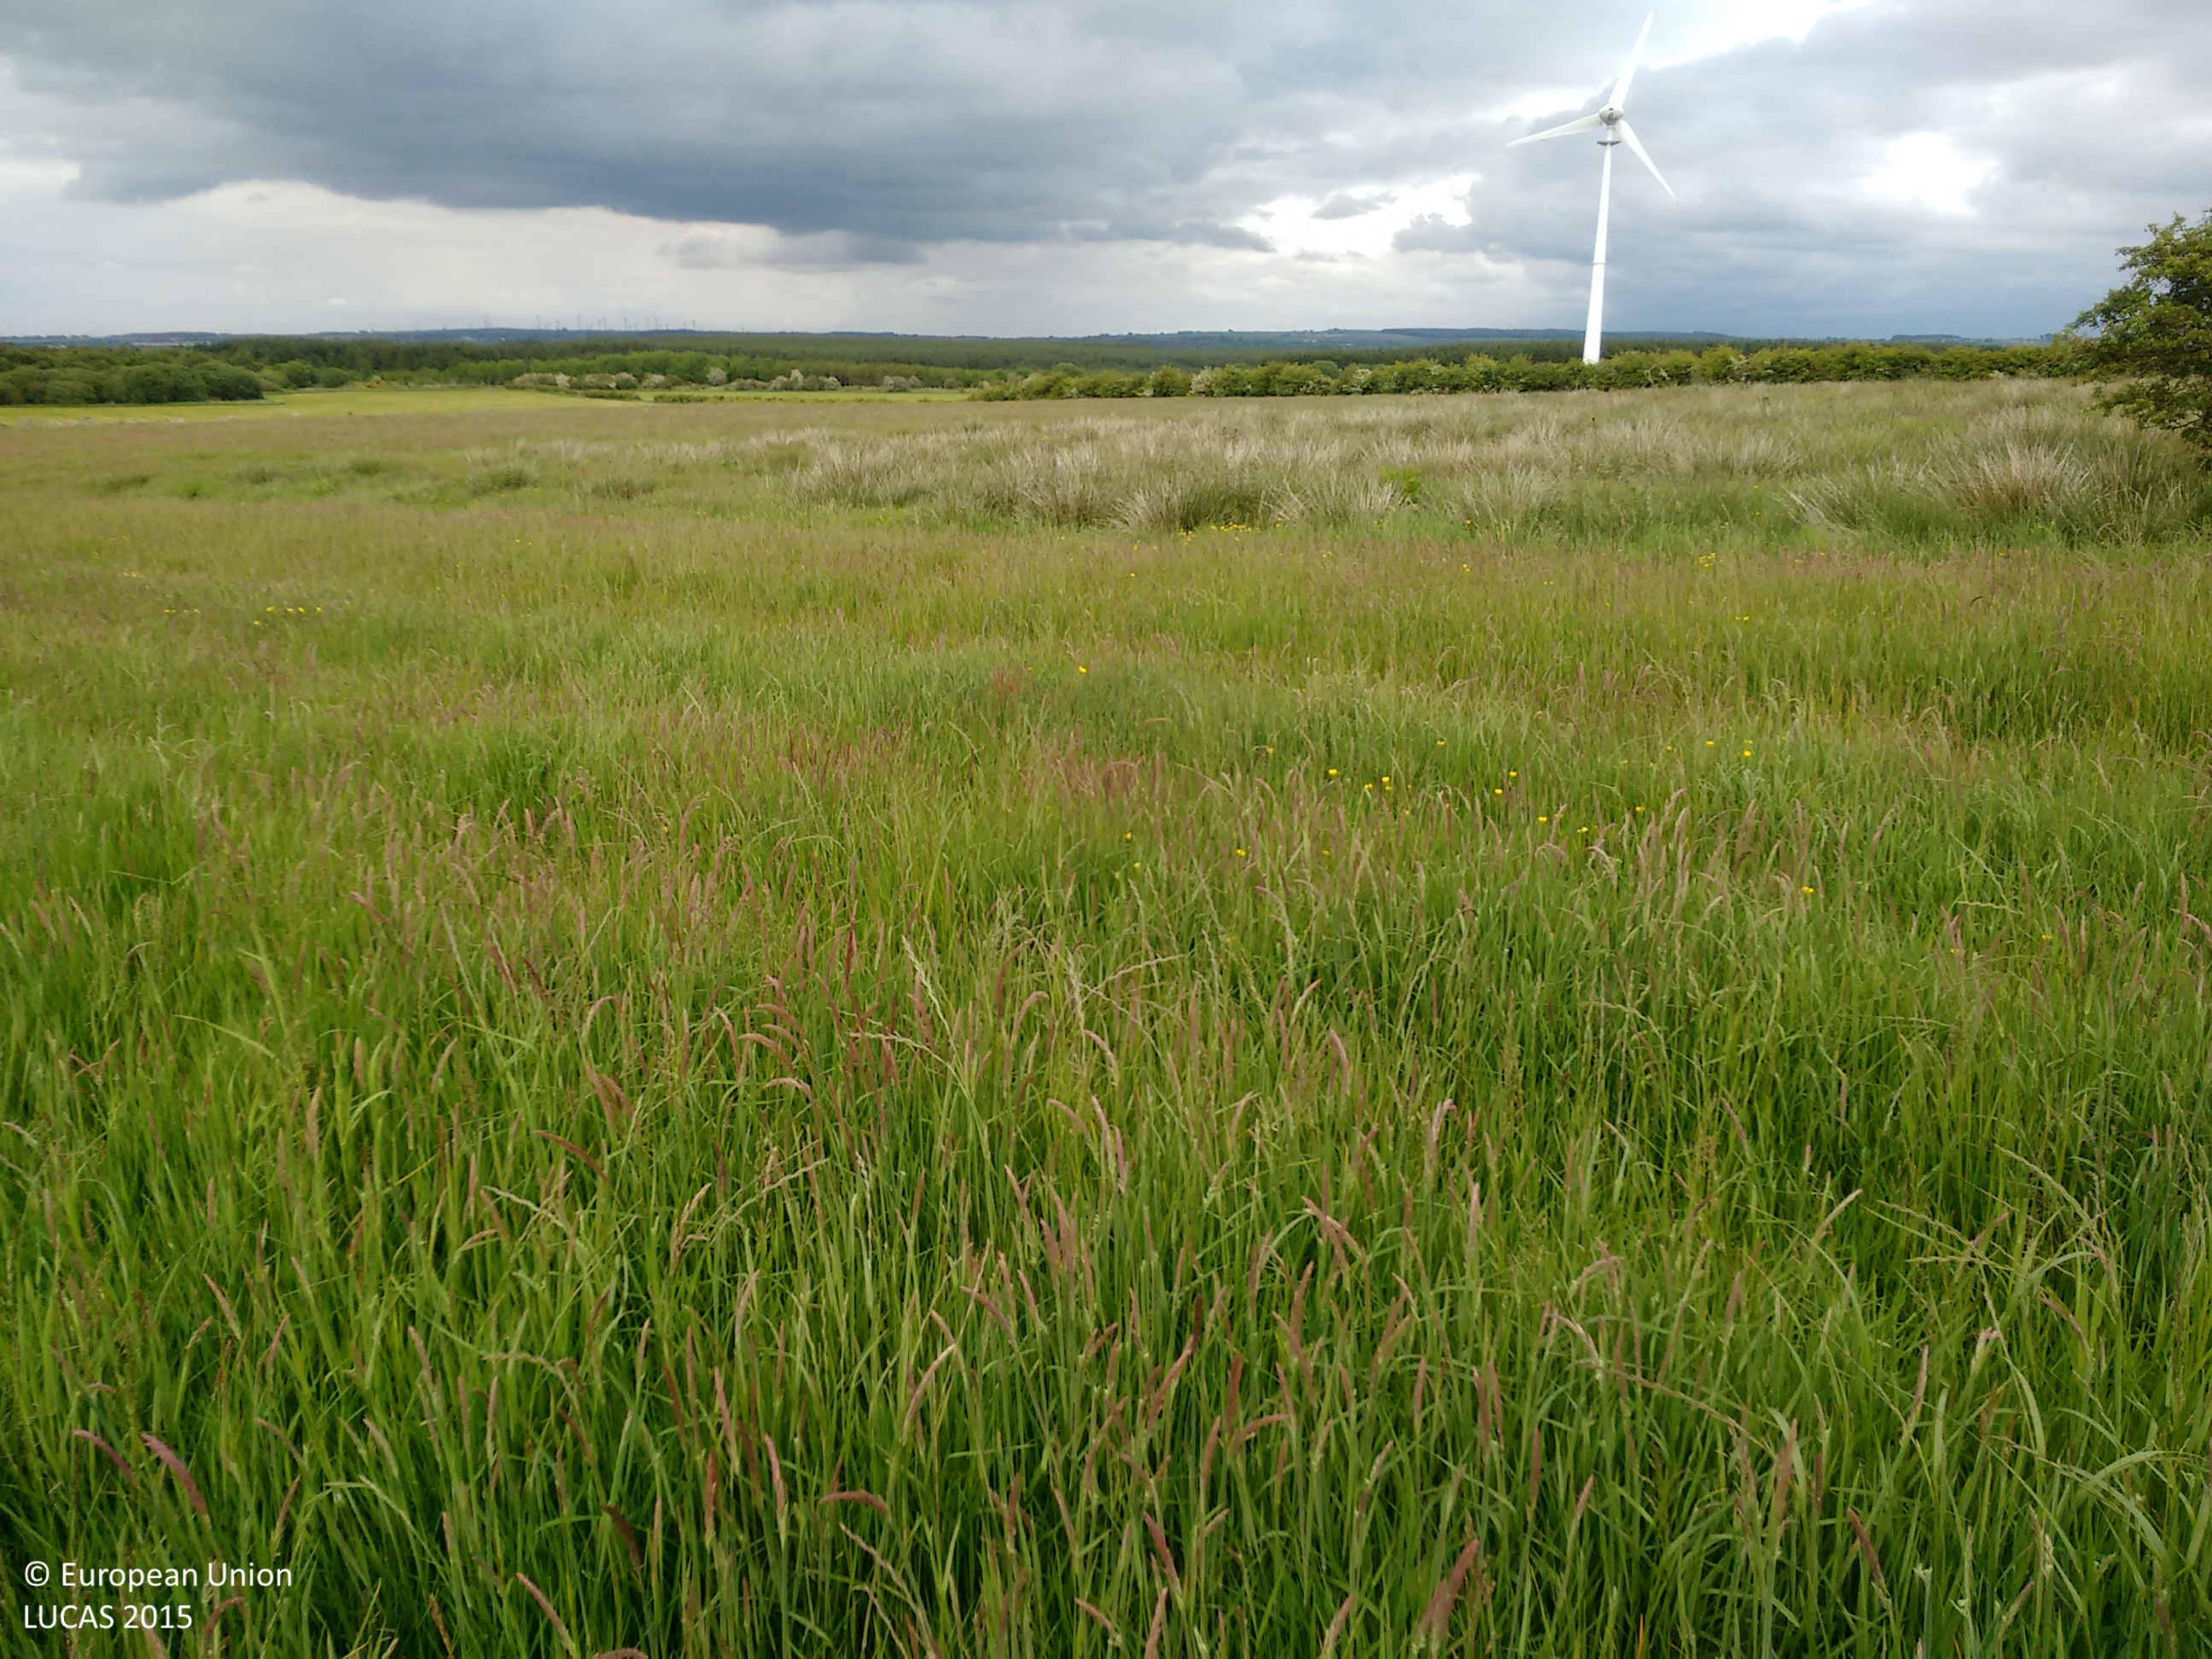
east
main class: Grassland
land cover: Grassland without tree/shrub cover
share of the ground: > 75 %
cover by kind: herbaceous plants 100 %
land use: Agriculture (excluding fallow land and kitchen gardens)
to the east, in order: Grassland without tree/shrub cover; Fences; Managed hedges; Grassland without tree/shrub cover
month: June
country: GB
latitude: 55.6988
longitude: -3.9133
